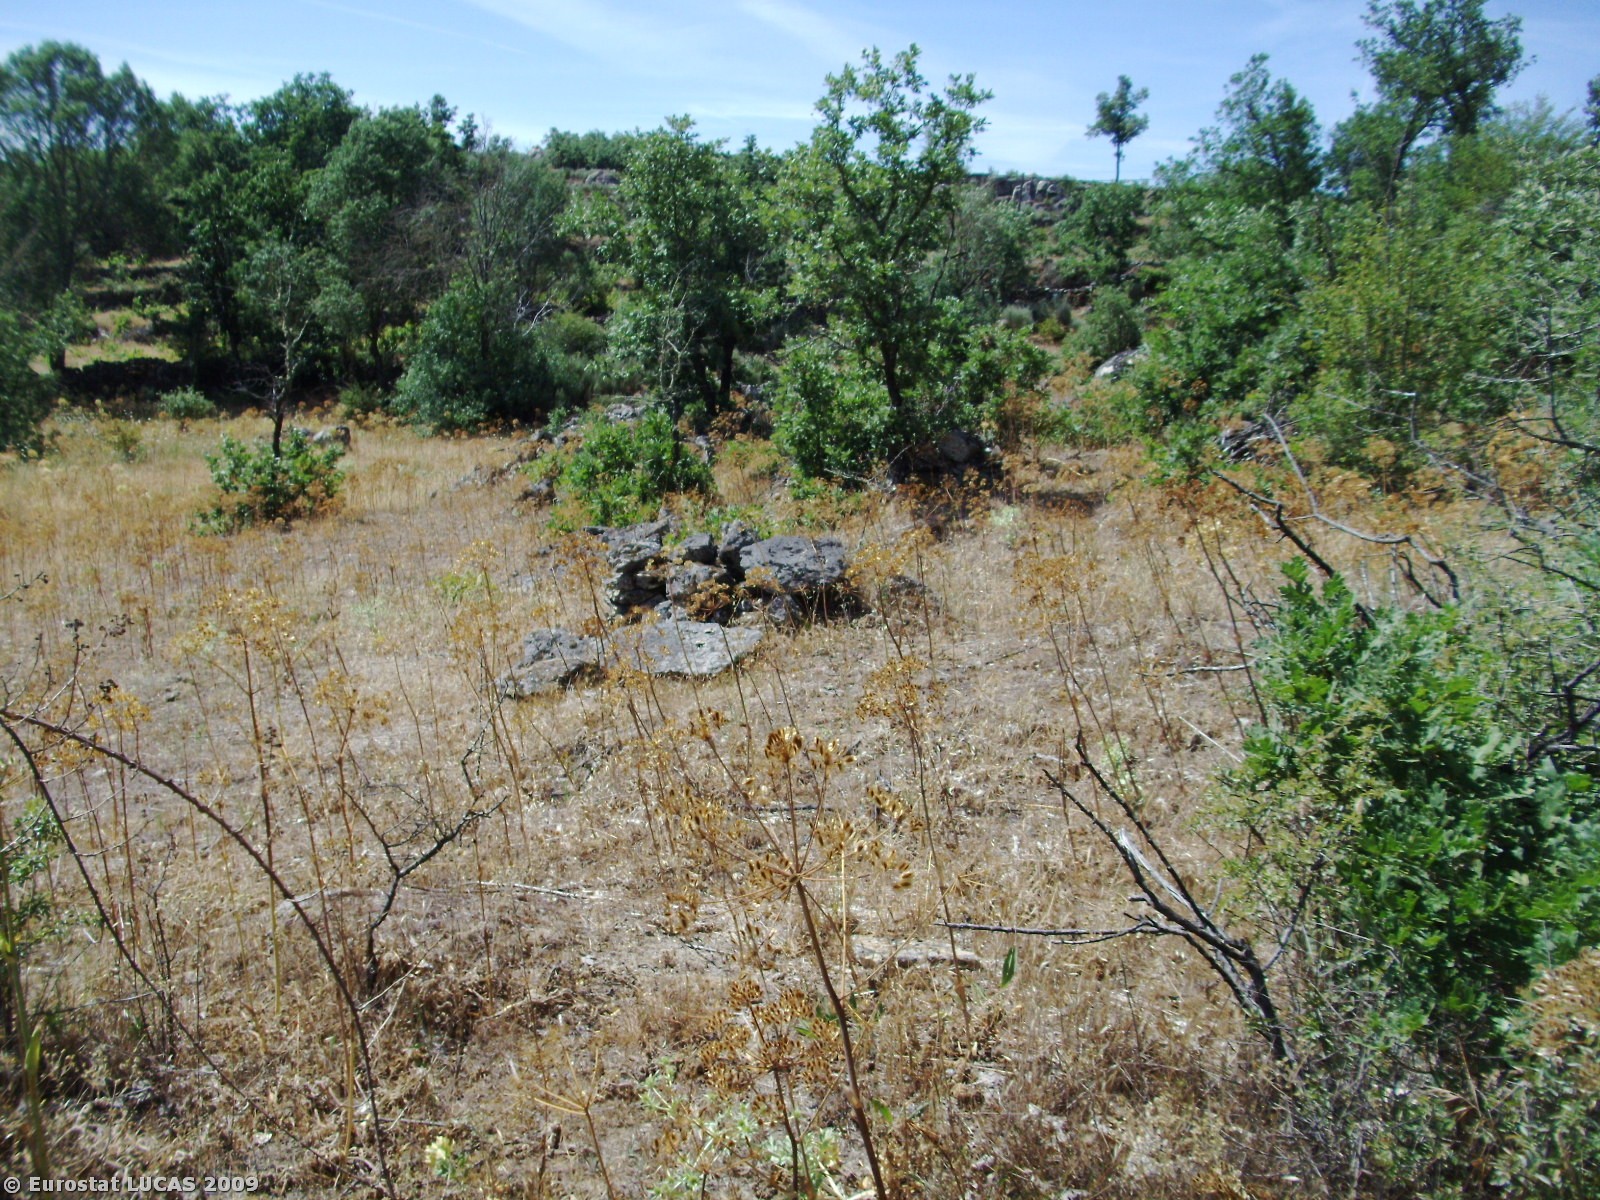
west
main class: Woodland
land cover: Broadleaved woodland
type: acidophilous oak and oak-birch forest
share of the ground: 50 - 75 %
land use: Forestry
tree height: > 5 m
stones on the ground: > 50 %
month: July
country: PT
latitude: 40.4637
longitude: -7.0223
